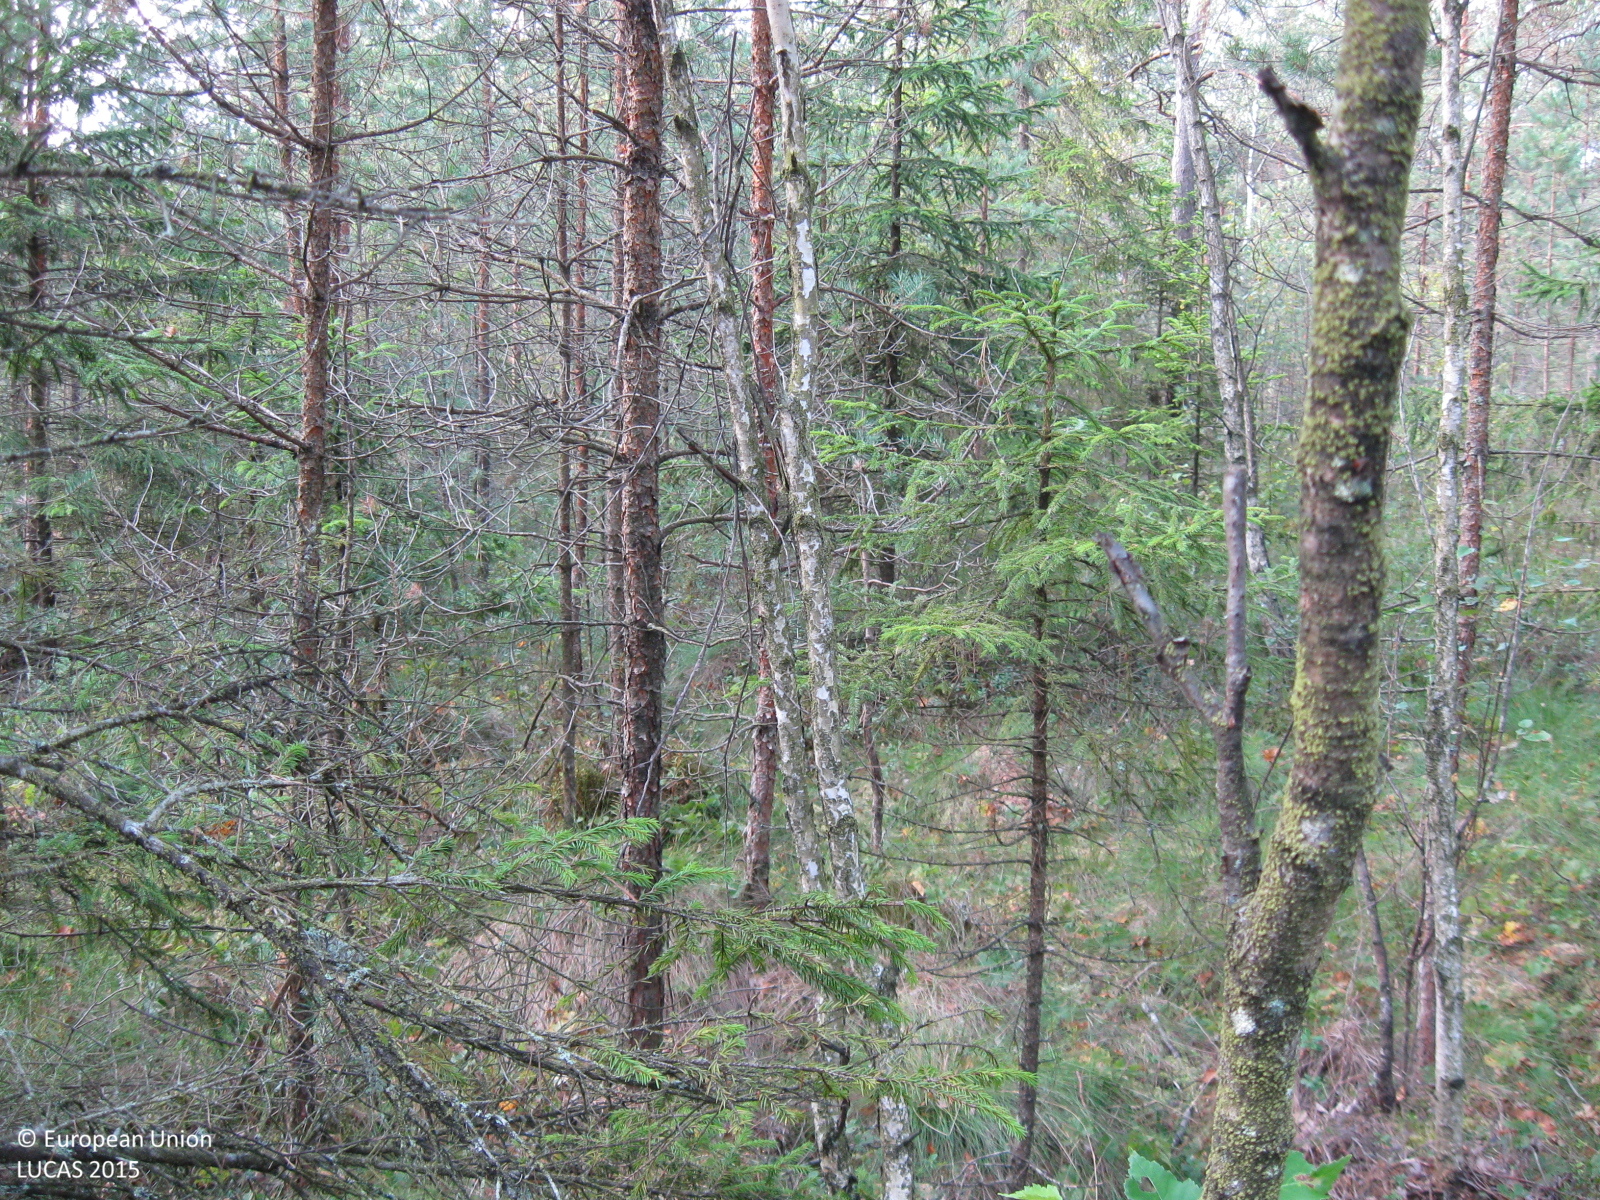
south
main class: Woodland
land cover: Pine dominated mixed woodland
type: mire and swamp forests
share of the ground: > 75 %
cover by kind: coniferous forest trees 50 %, broadleaved forest trees 30 %, shrubs 10 %, herbaceous plants 5 %, lichens and mosses 5 %
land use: Forestry
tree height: > 5 m
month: August
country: LT
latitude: 55.5242
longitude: 23.3342
